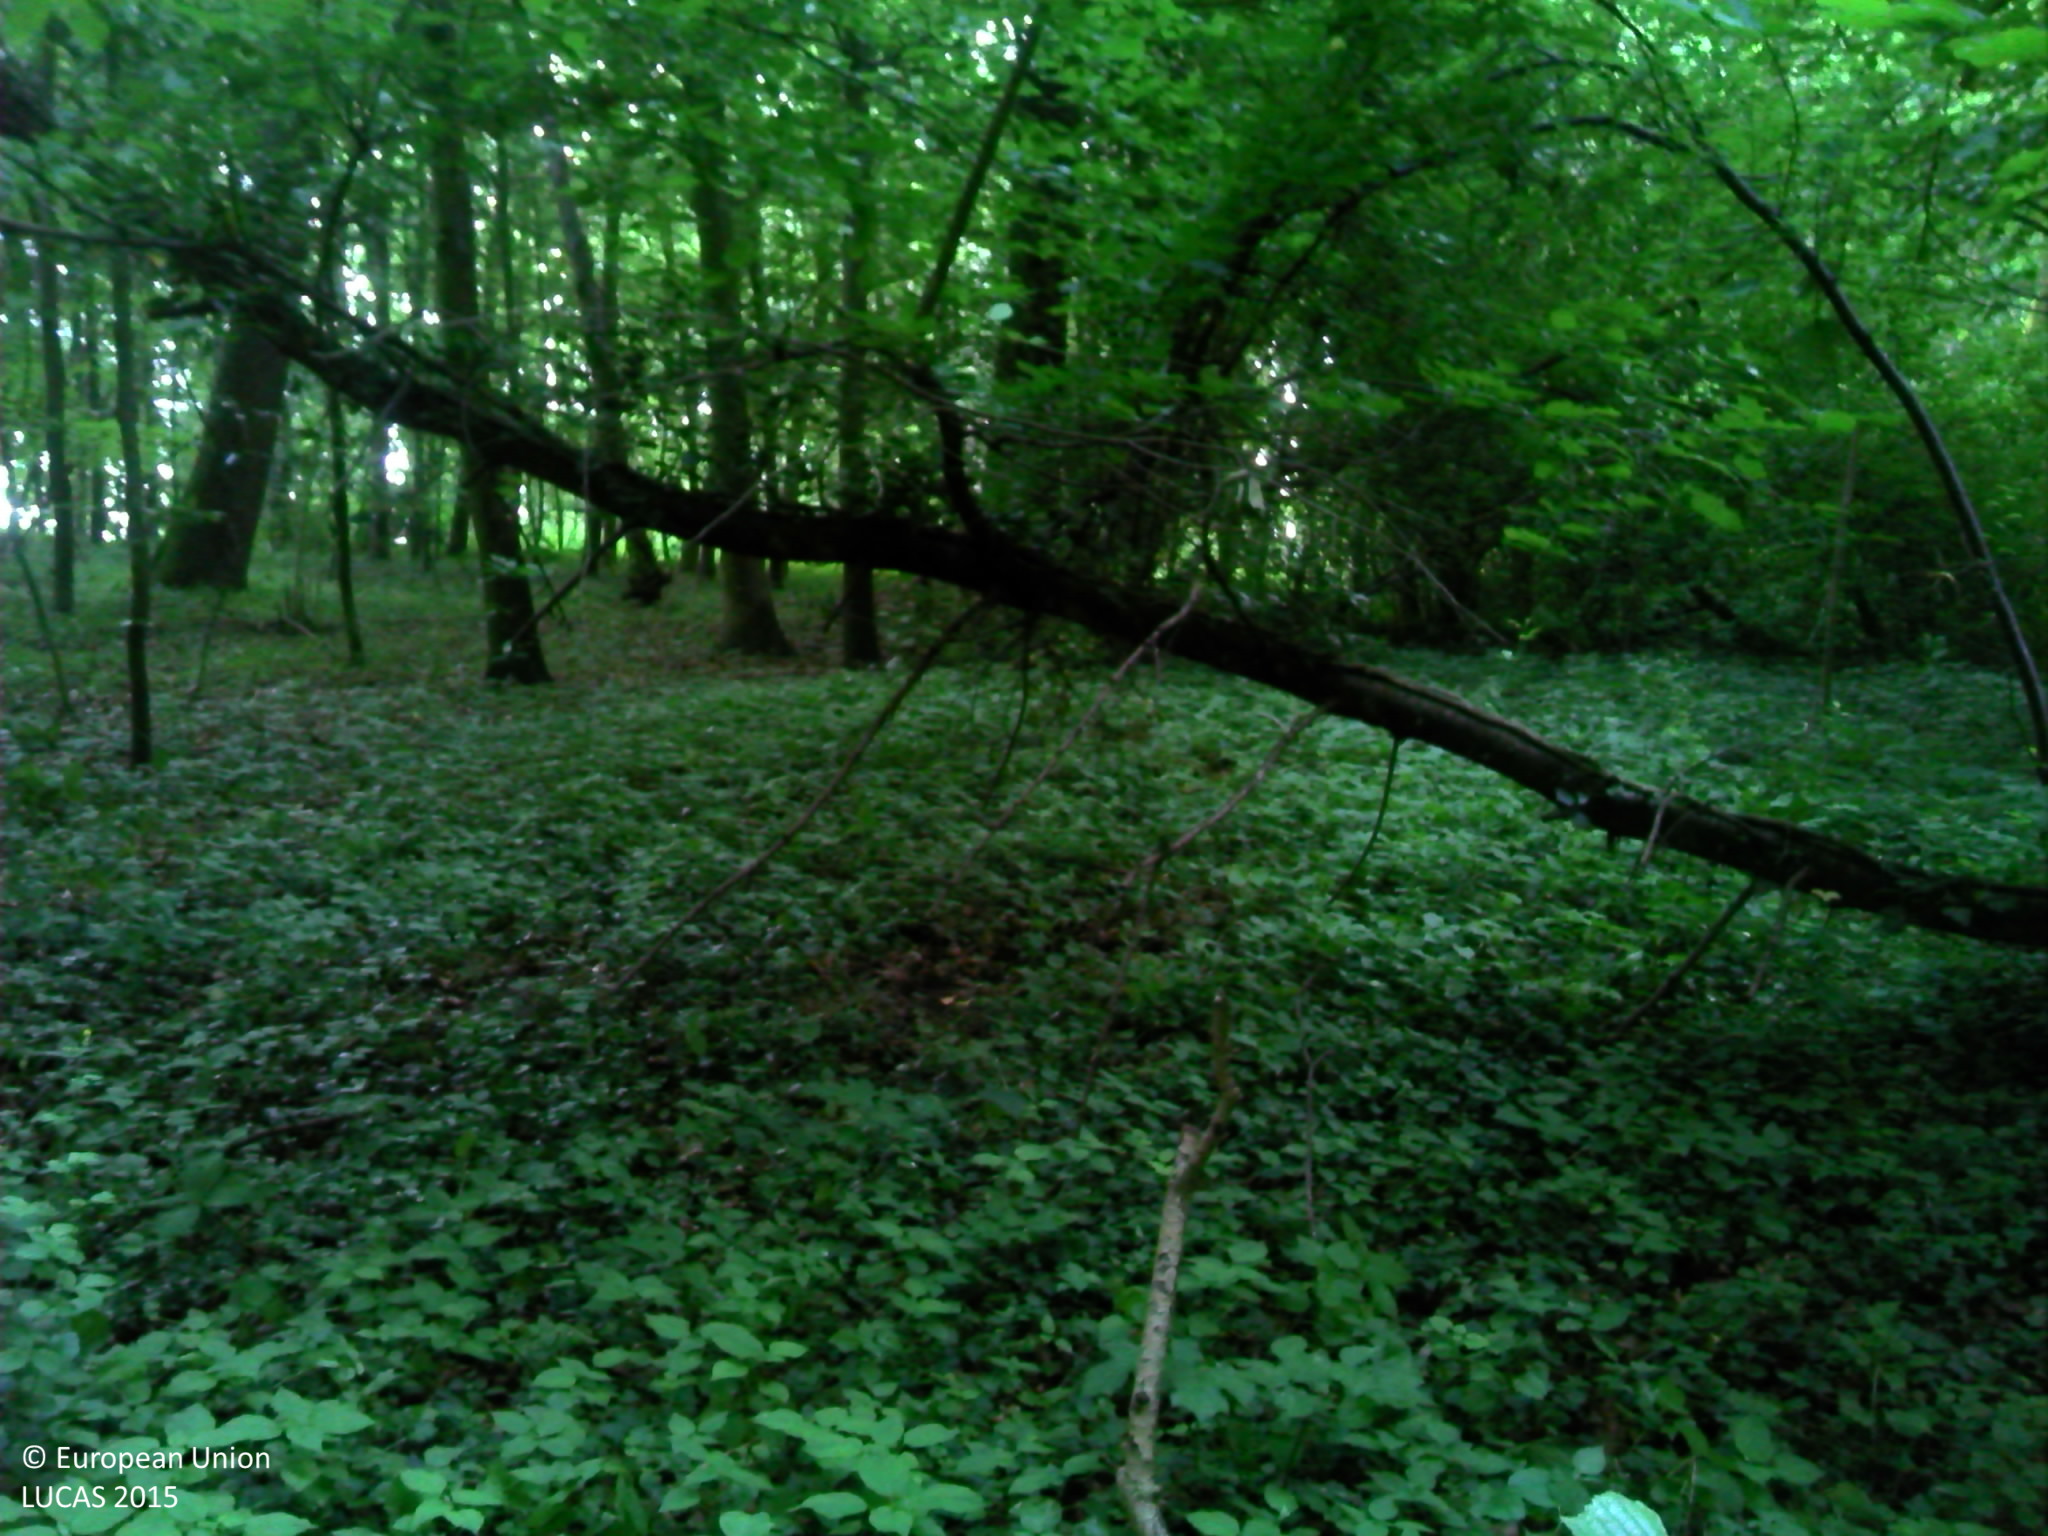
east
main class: Woodland
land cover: Broadleaved woodland
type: beech forest
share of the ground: > 75 %
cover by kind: broadleaved forest trees 95 %, herbaceous plants 5 %
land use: Forestry
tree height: > 5 m
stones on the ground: < 10 %
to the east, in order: Broadleaved woodland; Tracks; Broadleaved woodland; Ditches and canals; Broadleaved woodland; Grass margins; Tracks; Grass margins; Ditches and canals; Common wheat
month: June
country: FR
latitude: 47.6162
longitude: 7.3806
